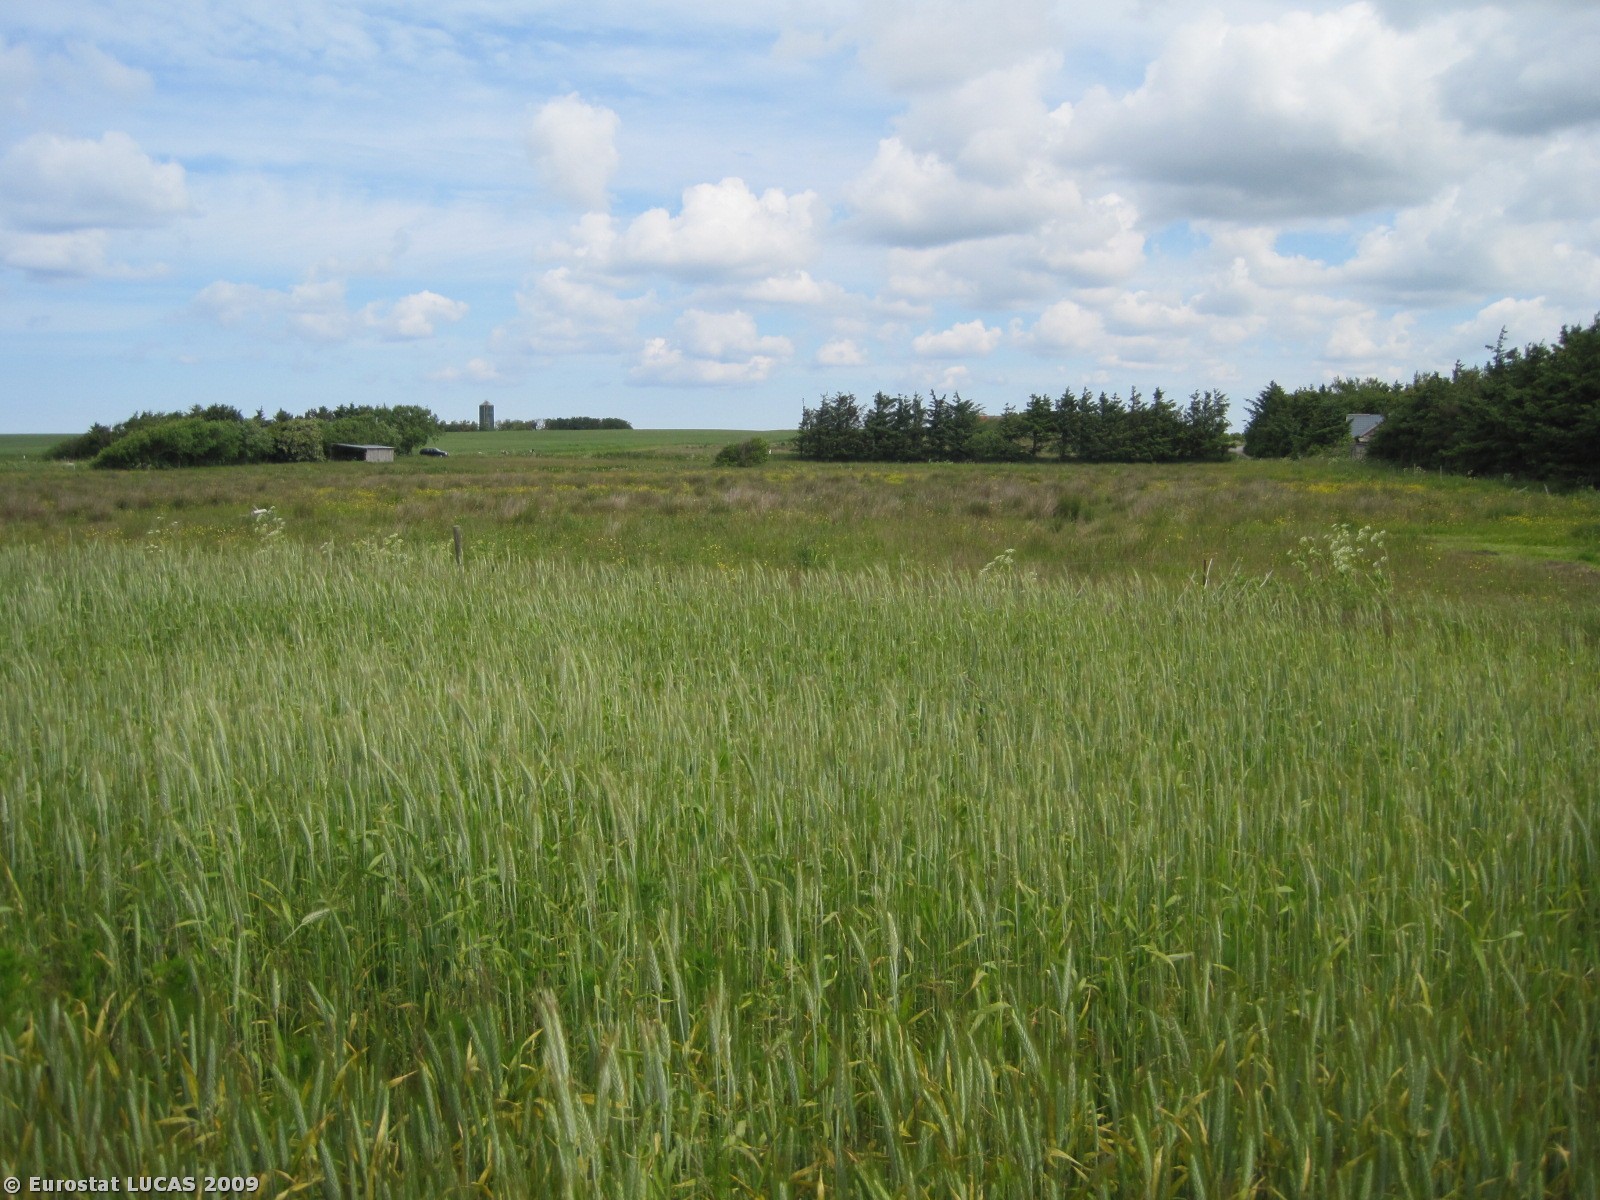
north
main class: Cropland
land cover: Barley
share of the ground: > 75 %
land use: Agriculture (excluding fallow land and kitchen gardens)
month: June
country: DK
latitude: 57.3740
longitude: 9.7510
